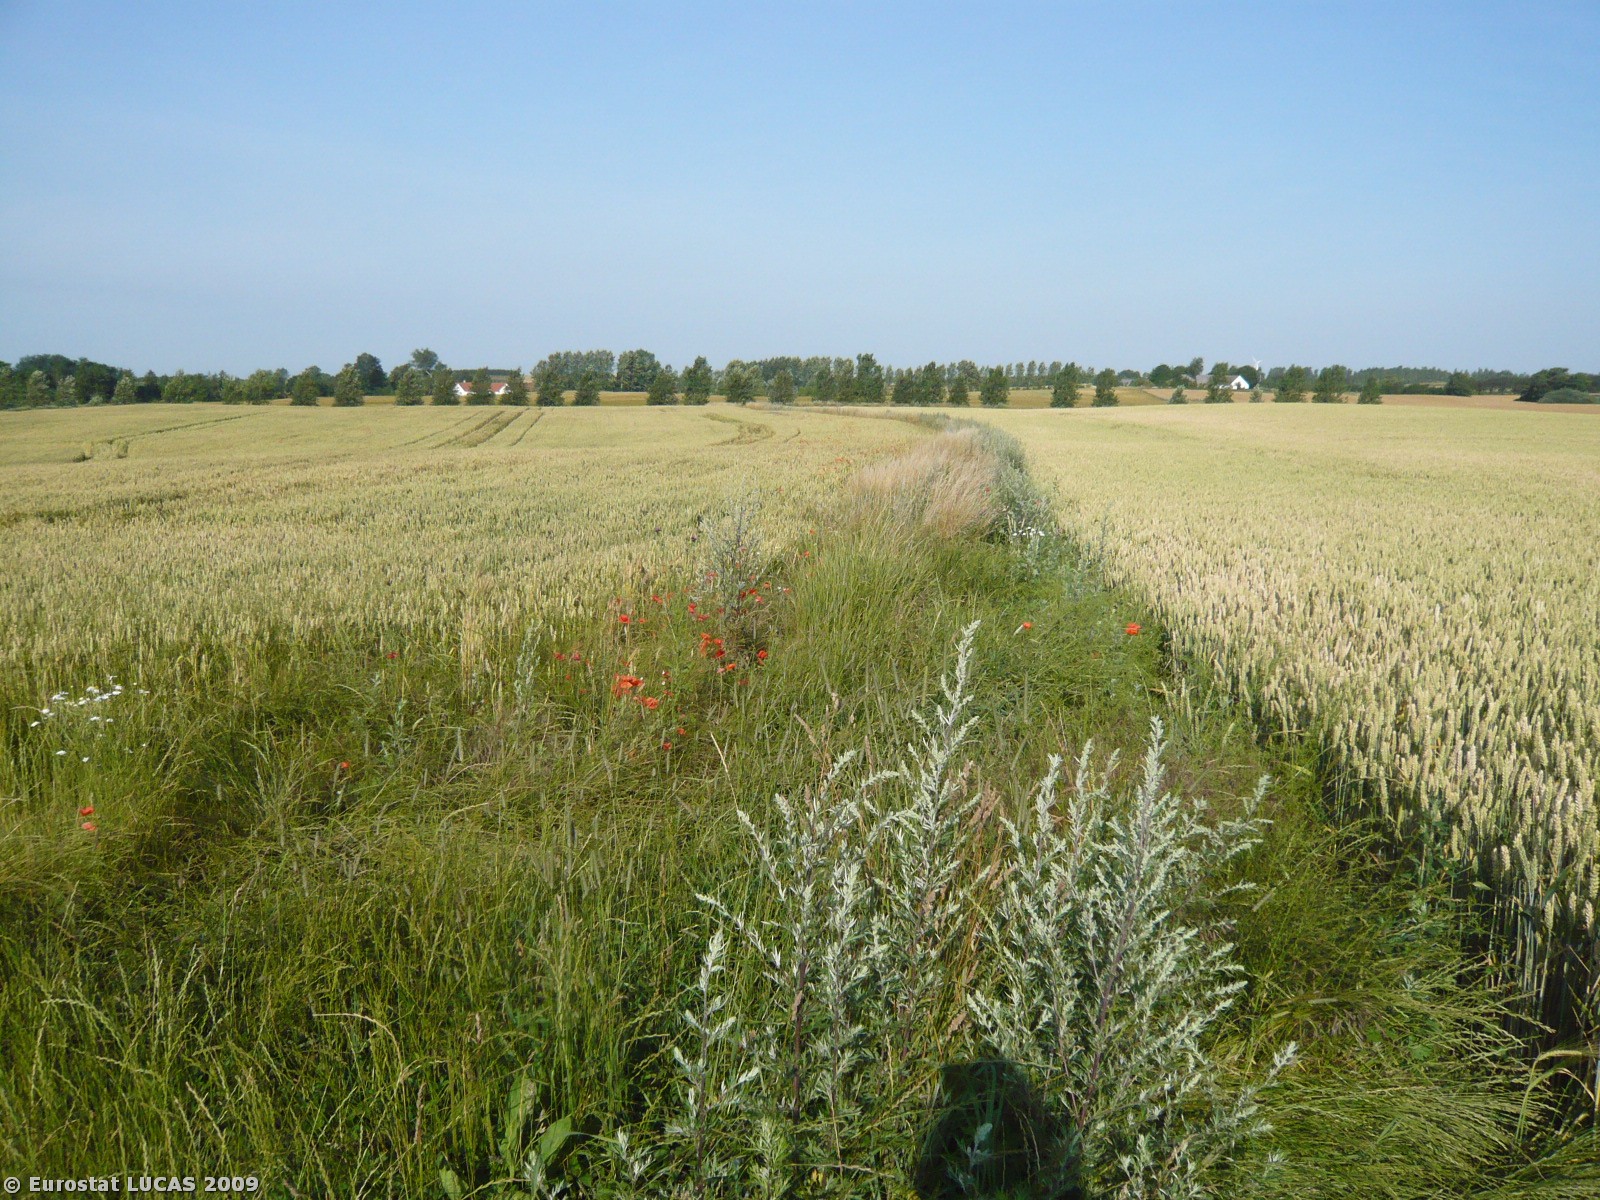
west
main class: Cropland
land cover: Common wheat
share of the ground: > 75 %
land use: Agriculture (excluding fallow land and kitchen gardens)
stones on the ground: < 10 %
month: July
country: DK
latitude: 55.5832
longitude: 11.6960
